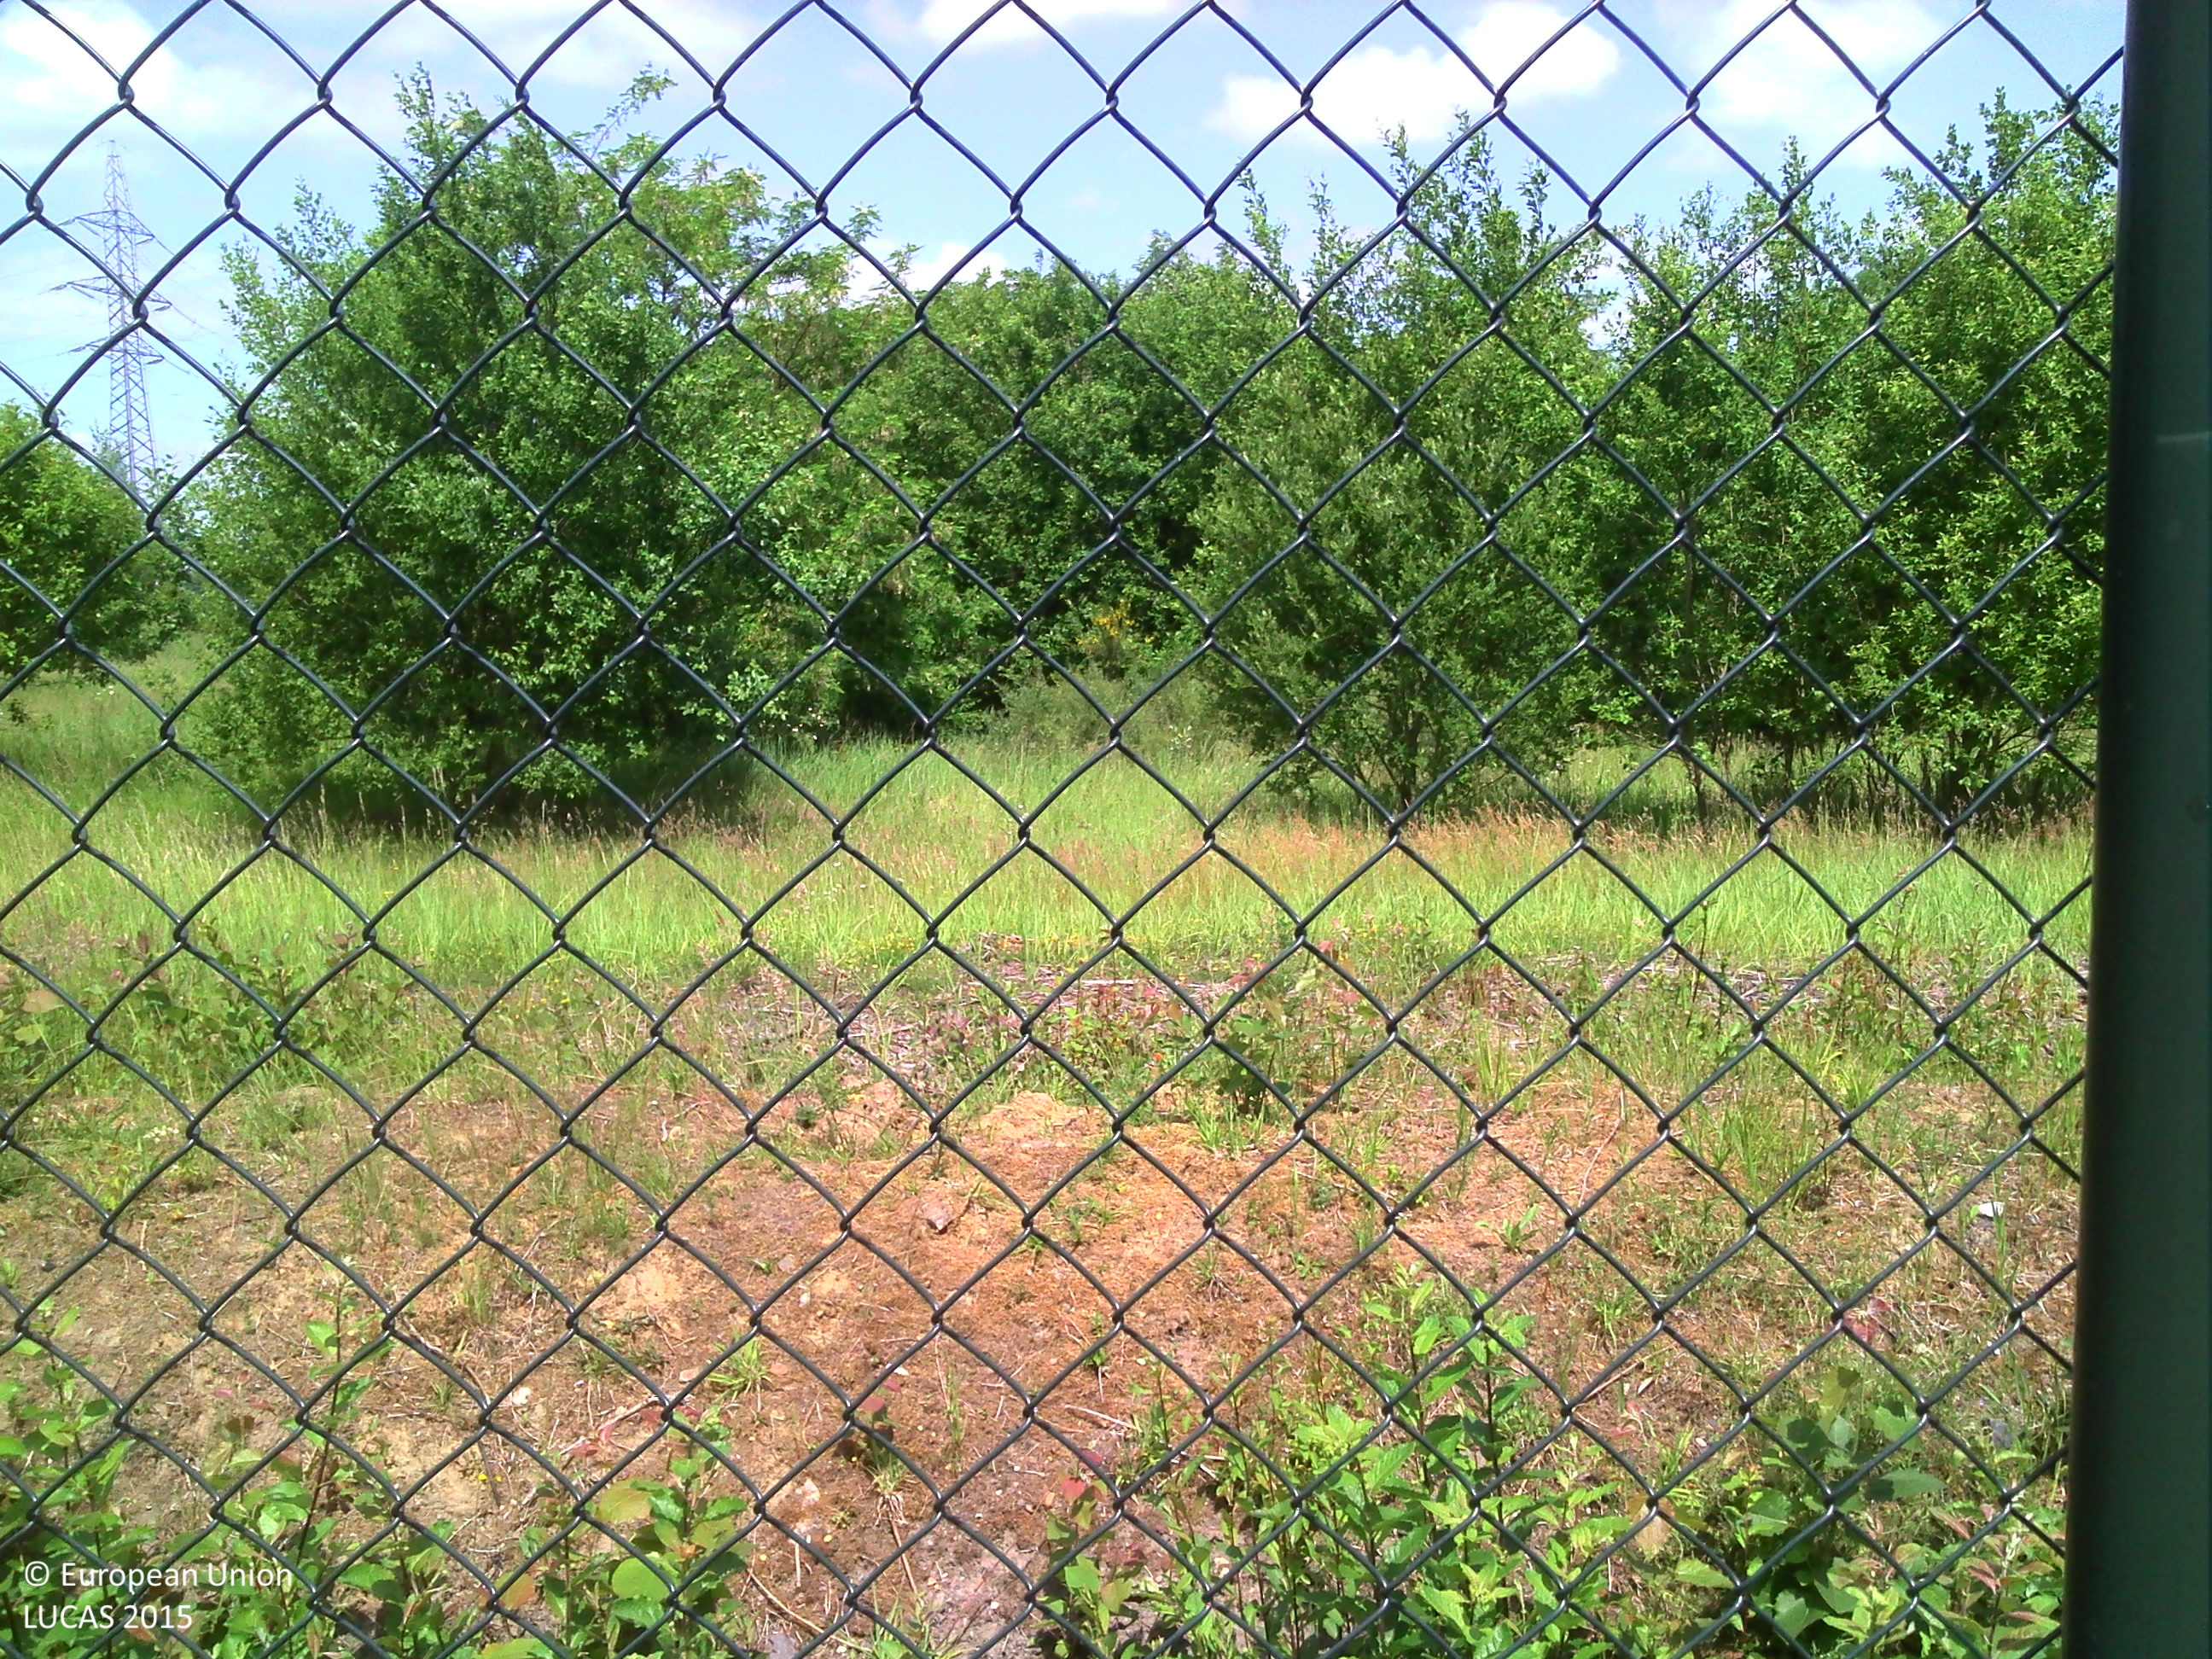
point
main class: Grassland
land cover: Grassland with sparse tree/shrub cover
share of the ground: > 75 %
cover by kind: herbaceous plants 95 %, broadleaved forest trees 5 %
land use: Semi-natural and natural areas not in use
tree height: < 5 m
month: June
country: BE
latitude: 51.0038
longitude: 5.7090
